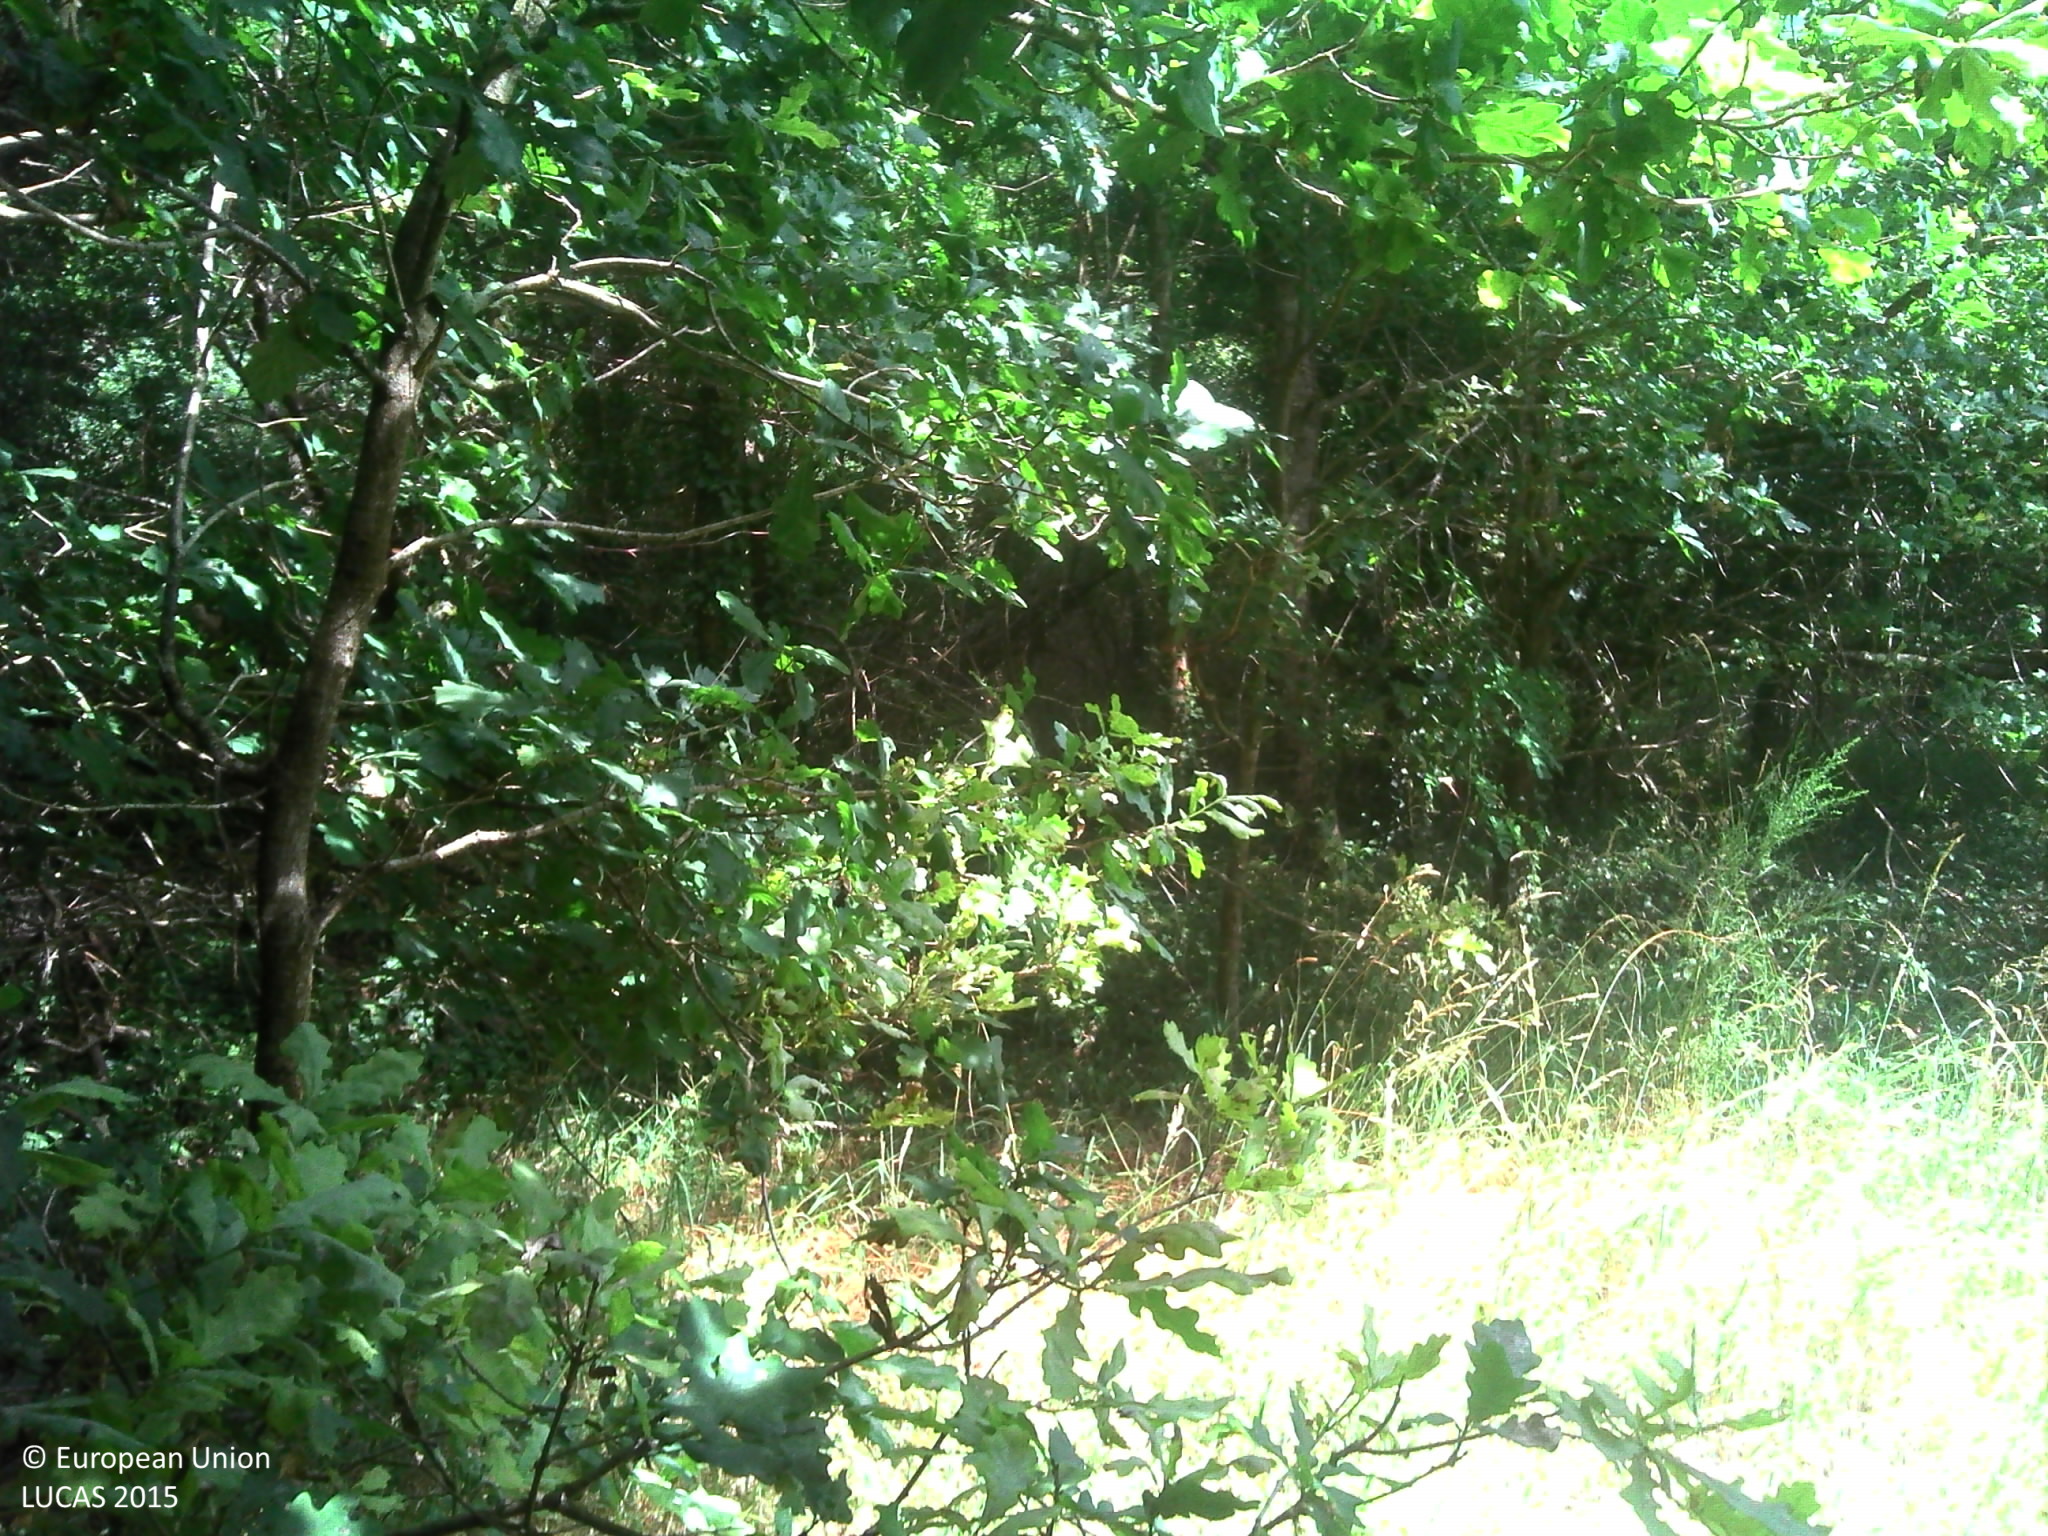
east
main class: Woodland
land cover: Broadleaved woodland
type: mesophytic deciduous forest
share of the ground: > 75 %
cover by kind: herbaceous plants 40 %, unconsolidated bare surface 40 %, broadleaved forest trees 20 %
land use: Forestry
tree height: > 5 m
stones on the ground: < 10 %
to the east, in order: Broadleaved woodland; Grass margins; Tracks; Broadleaved woodland; Fences; Maize; Other fresh vegetables; Fences; Grassland without tree/shrub cover; Broadleaved woodland
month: June
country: FR
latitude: 47.4372
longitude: 1.4336
